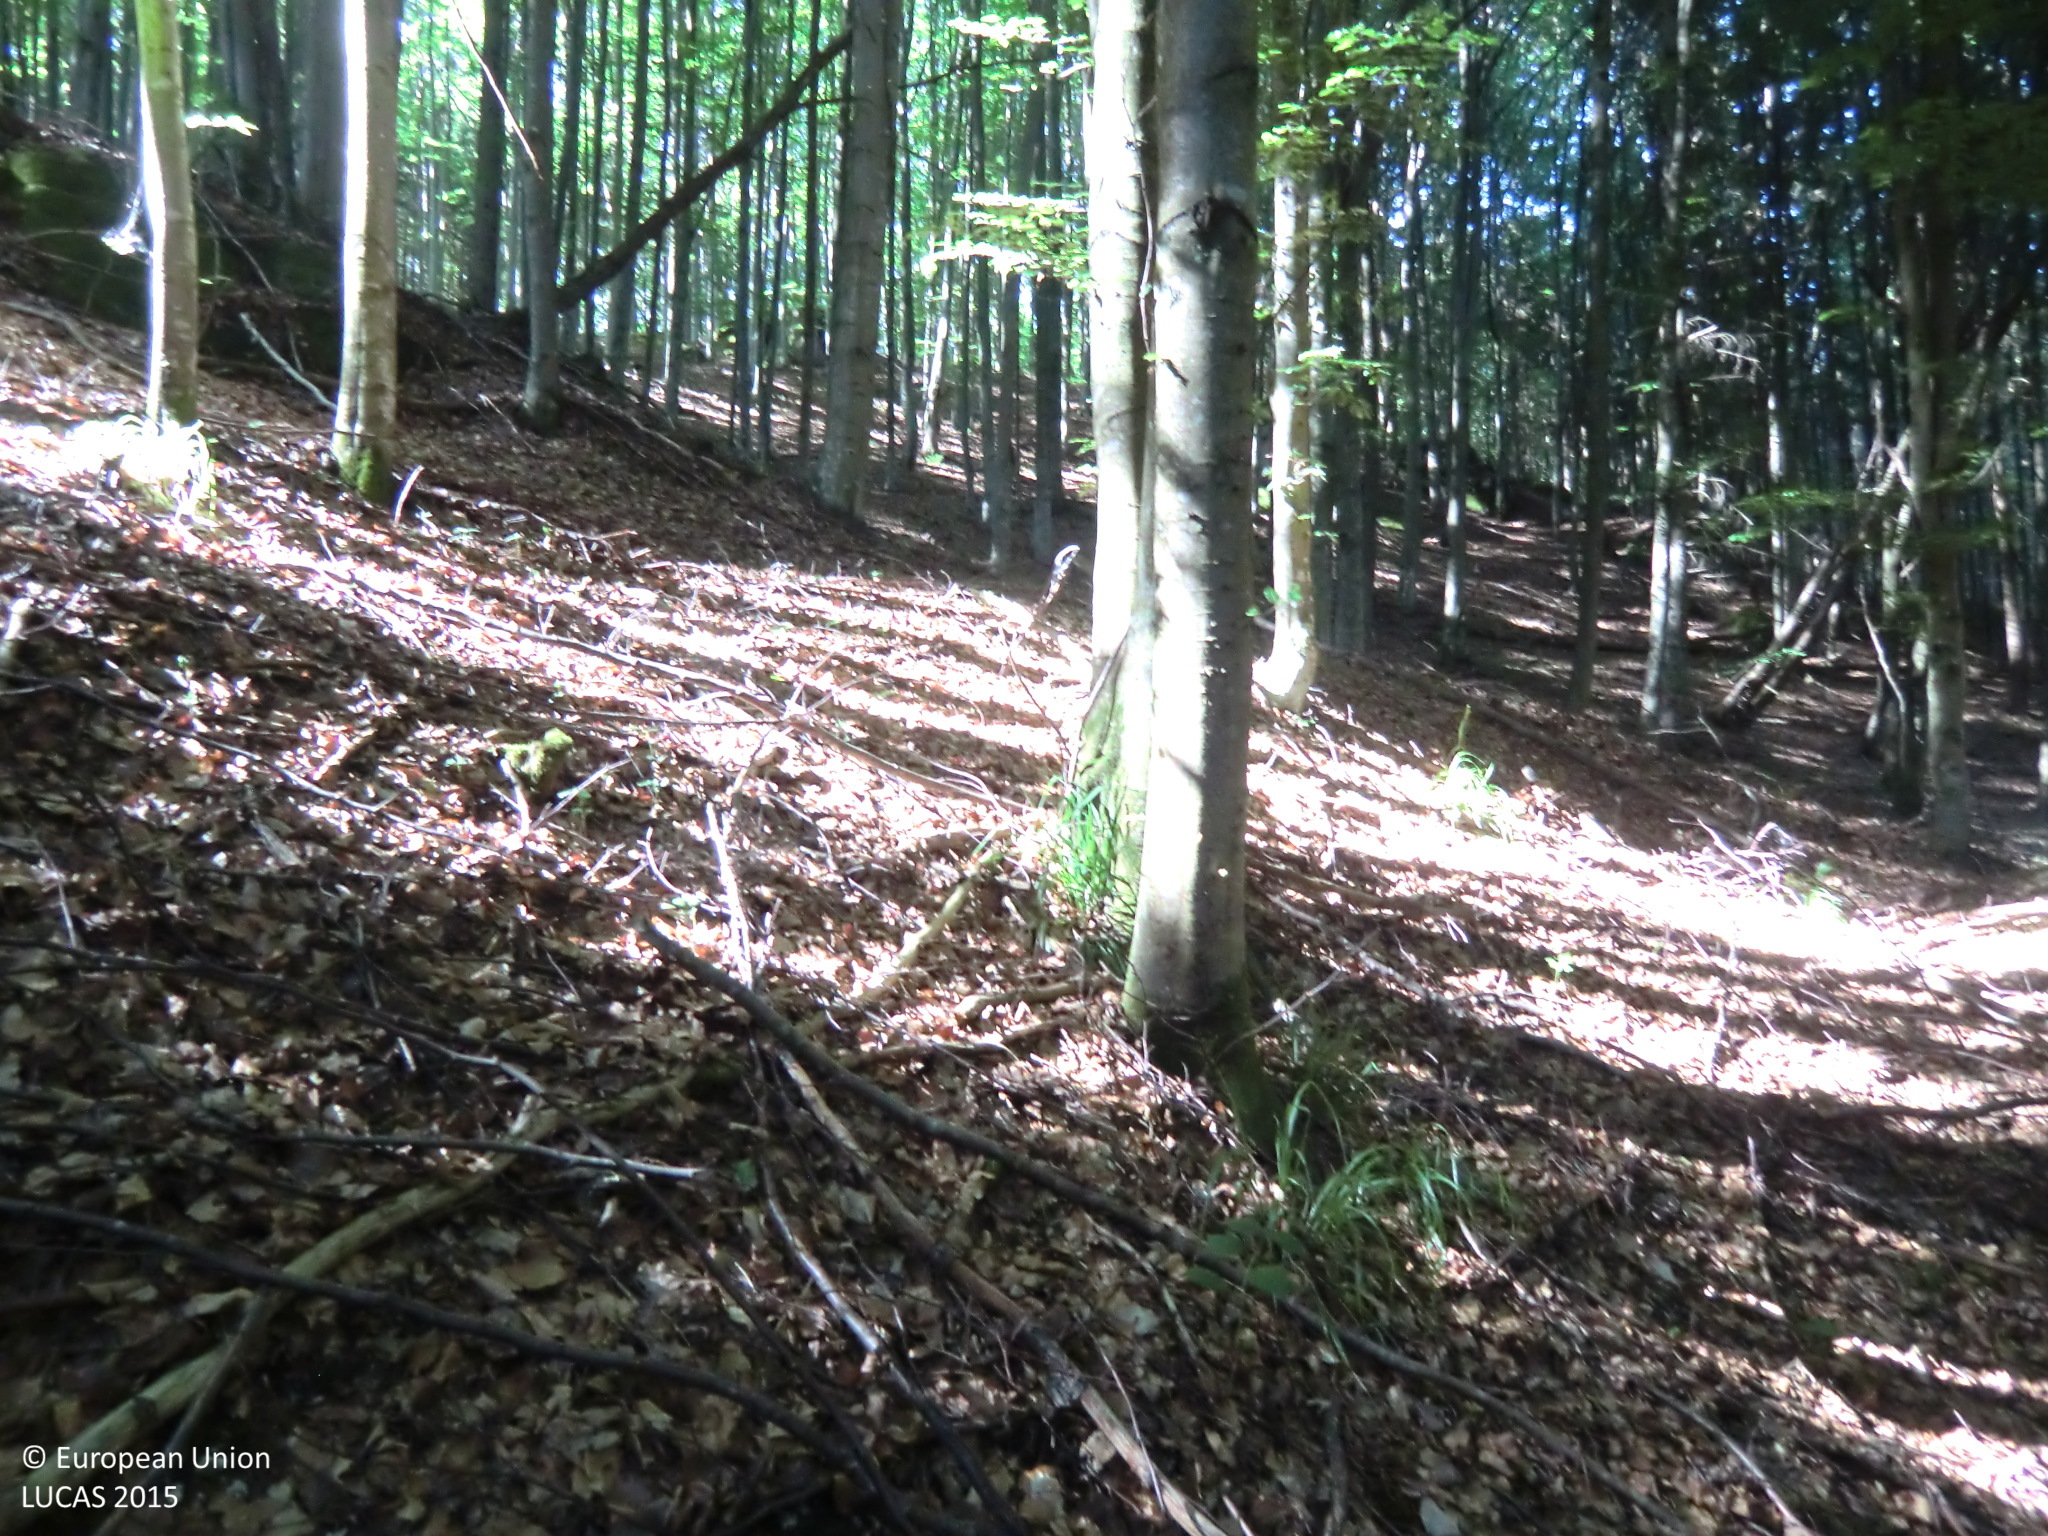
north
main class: Woodland
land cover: Spruce dominated mixed woodland
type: boreal forest
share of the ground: > 75 %
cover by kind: coniferous forest trees 45 %, broadleaved forest trees 45 %, unconsolidated bare surface 10 %
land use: Forestry
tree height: > 5 m
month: June
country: AT
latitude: 48.4147
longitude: 15.0412
